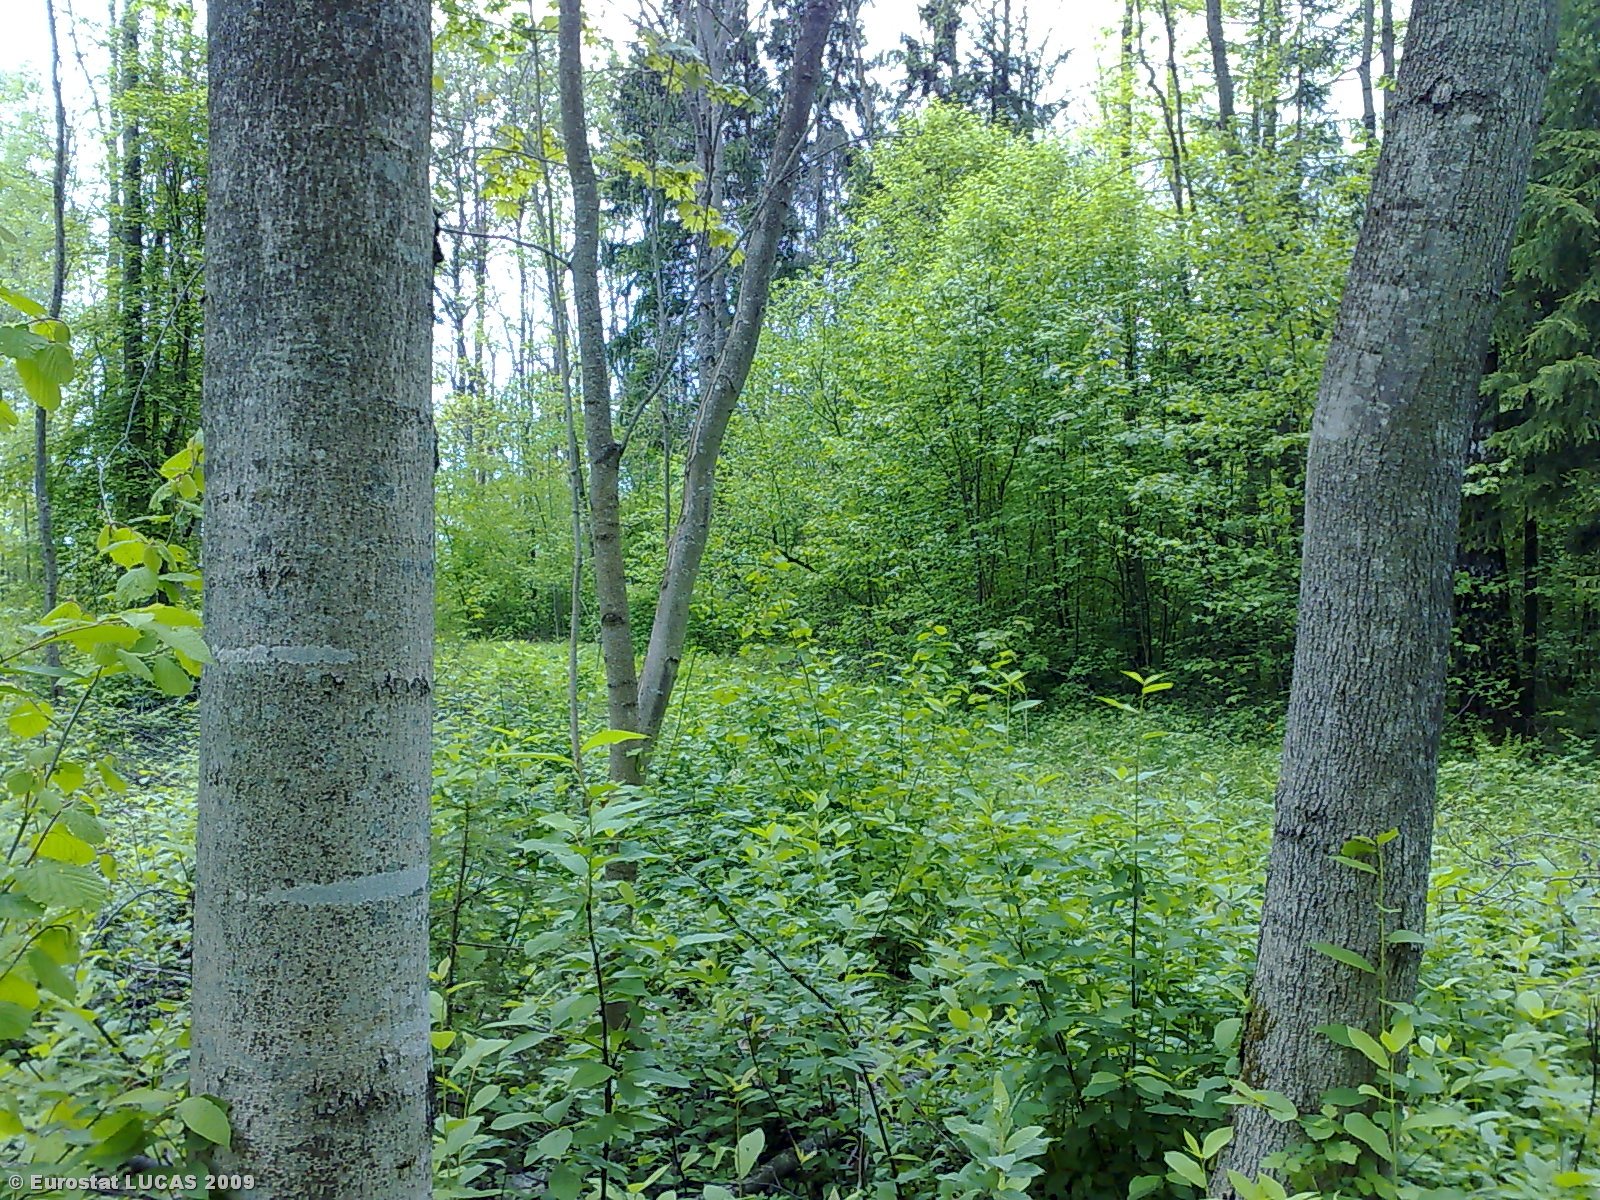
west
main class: Woodland
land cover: Broadleaved woodland
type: mesophytic deciduous forest
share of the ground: 50 - 75 %
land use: Forestry
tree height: > 5 m
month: May
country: LT
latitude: 55.6246
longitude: 23.7572
